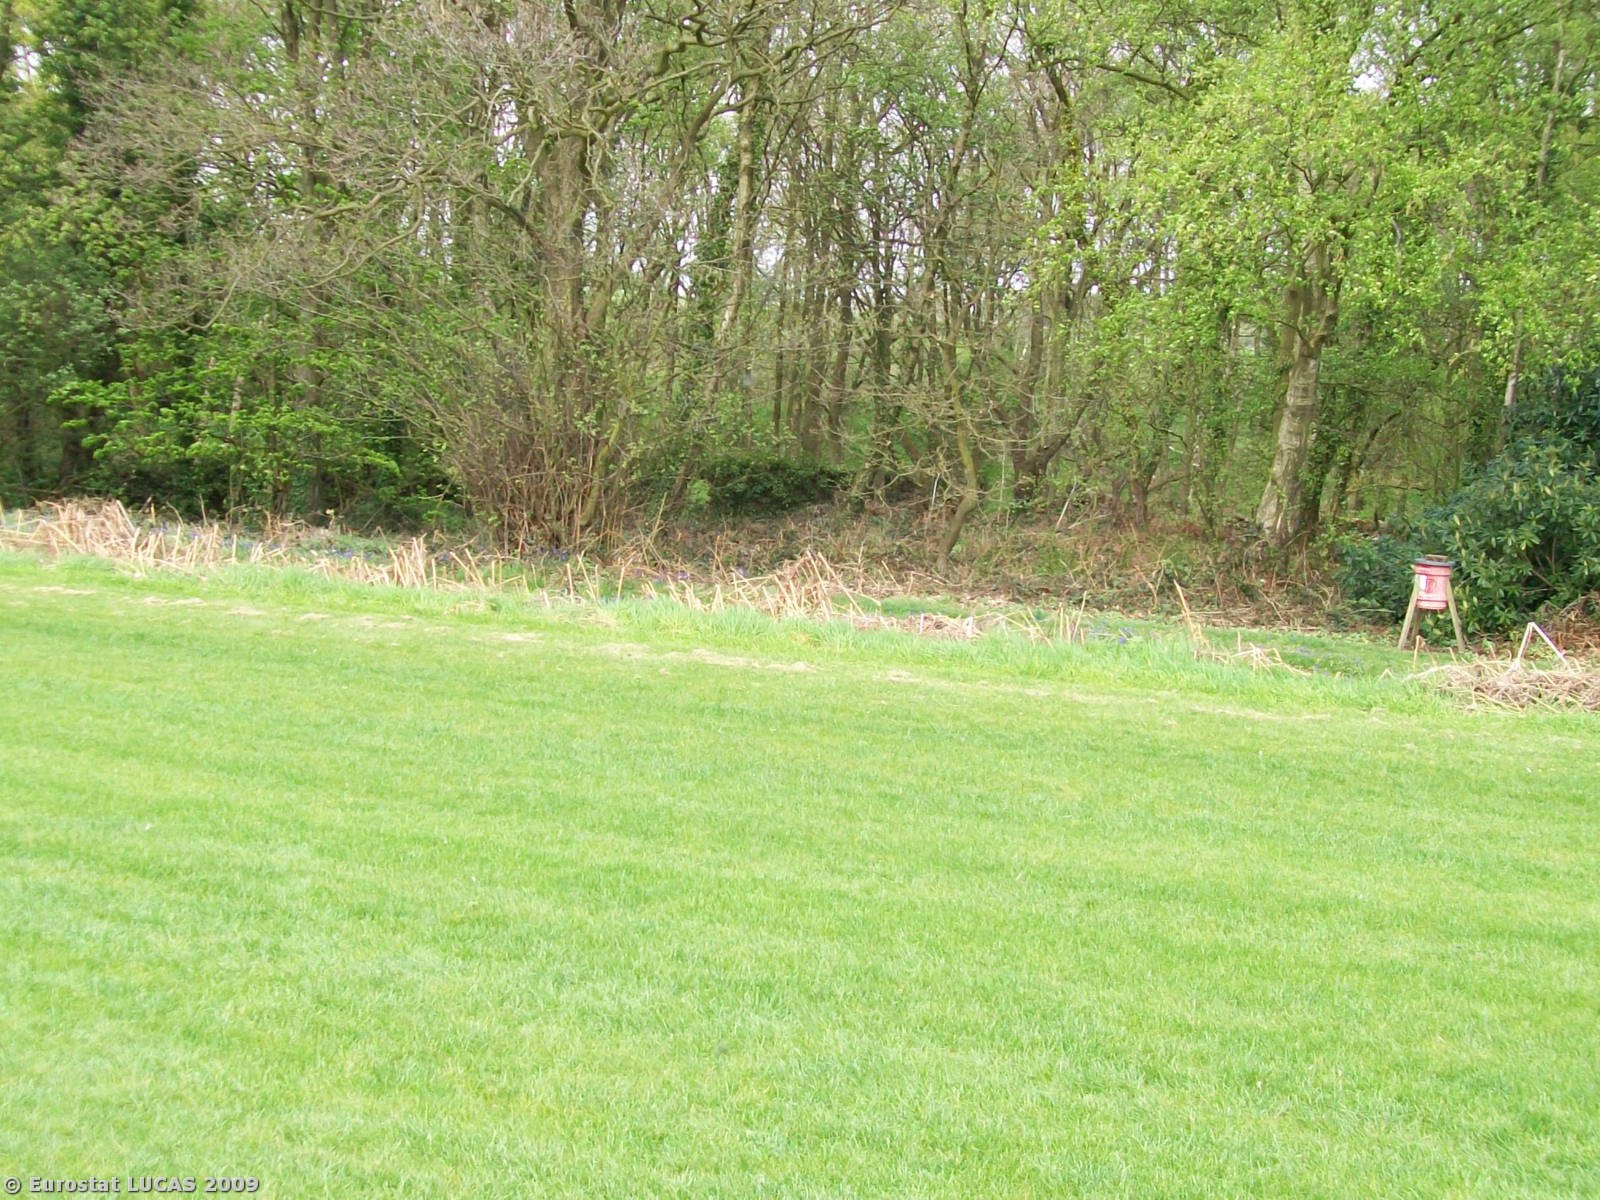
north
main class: Grassland
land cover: Grassland without tree/shrub cover
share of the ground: 50 - 75 %
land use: Agriculture (excluding fallow land and kitchen gardens)
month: April
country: GB
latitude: 53.5750
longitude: -2.8017
